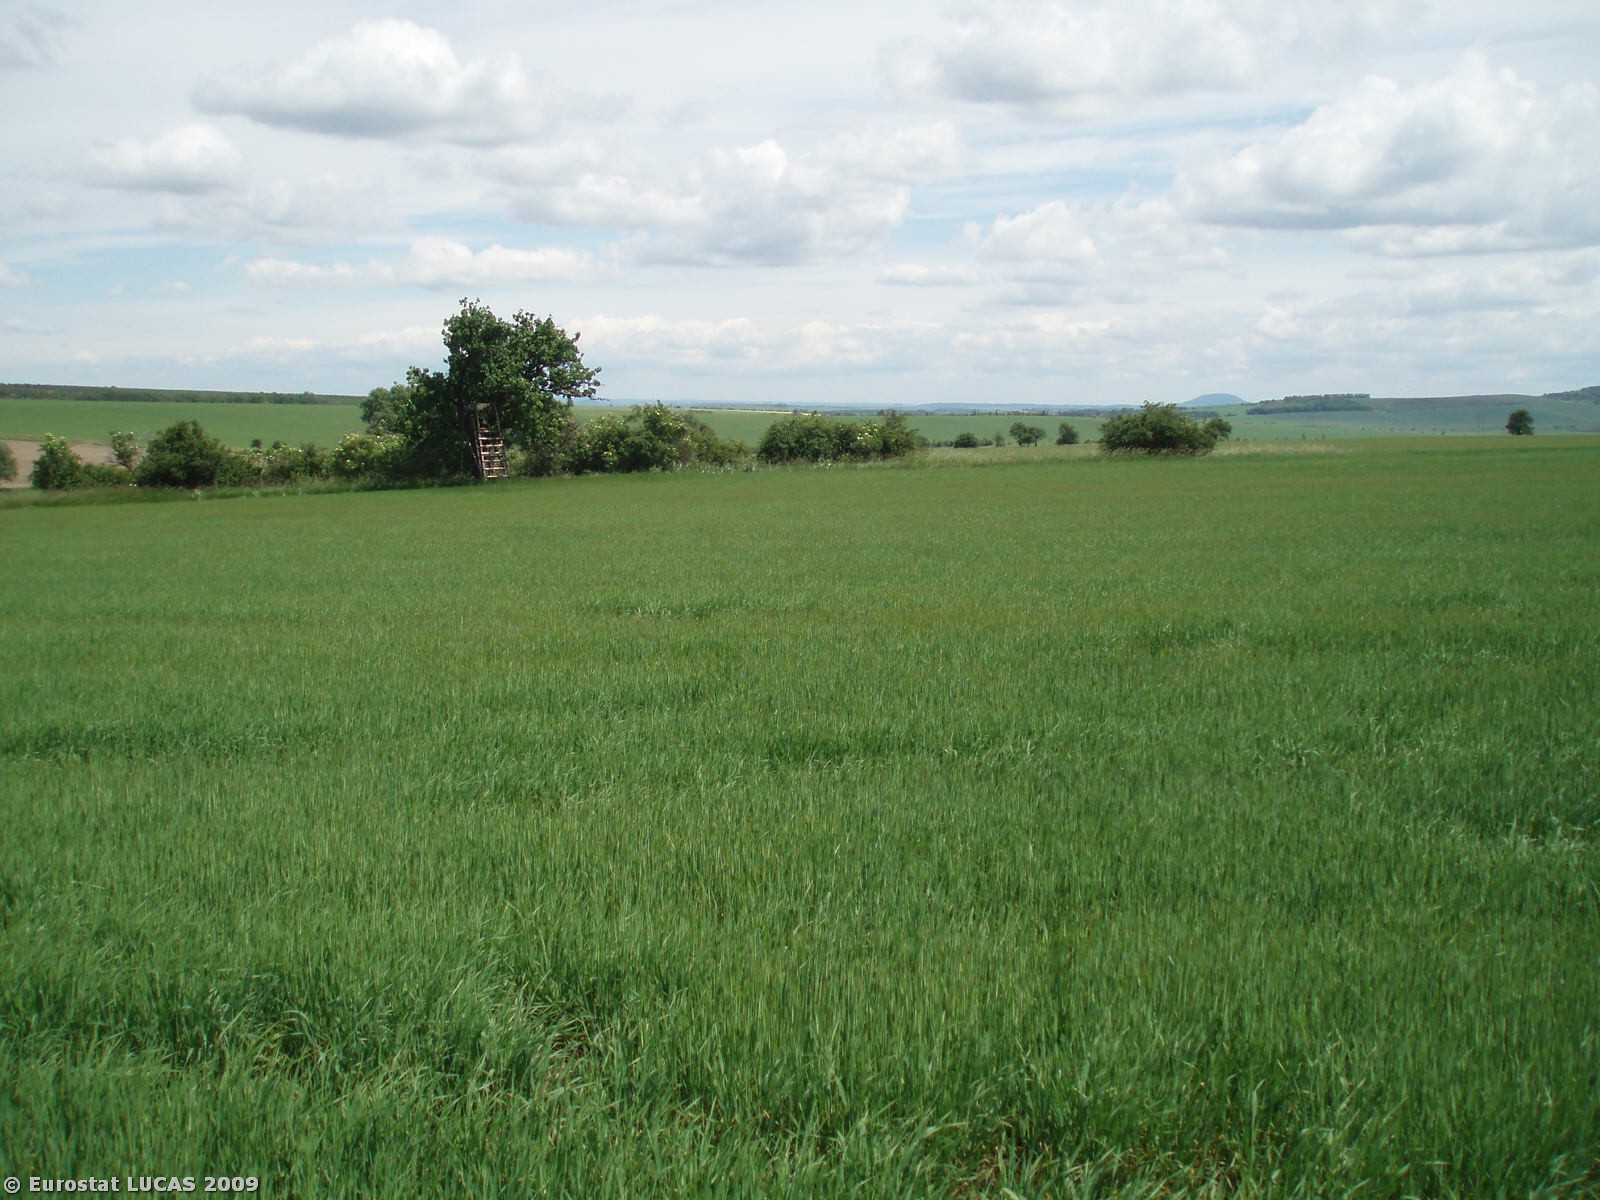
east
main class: Cropland
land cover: Barley
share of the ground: > 75 %
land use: Agriculture (excluding fallow land and kitchen gardens)
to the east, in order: Barley; Shrubland with sparse tree cover; Barley
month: June
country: CZ
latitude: 50.4576
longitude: 13.9590
